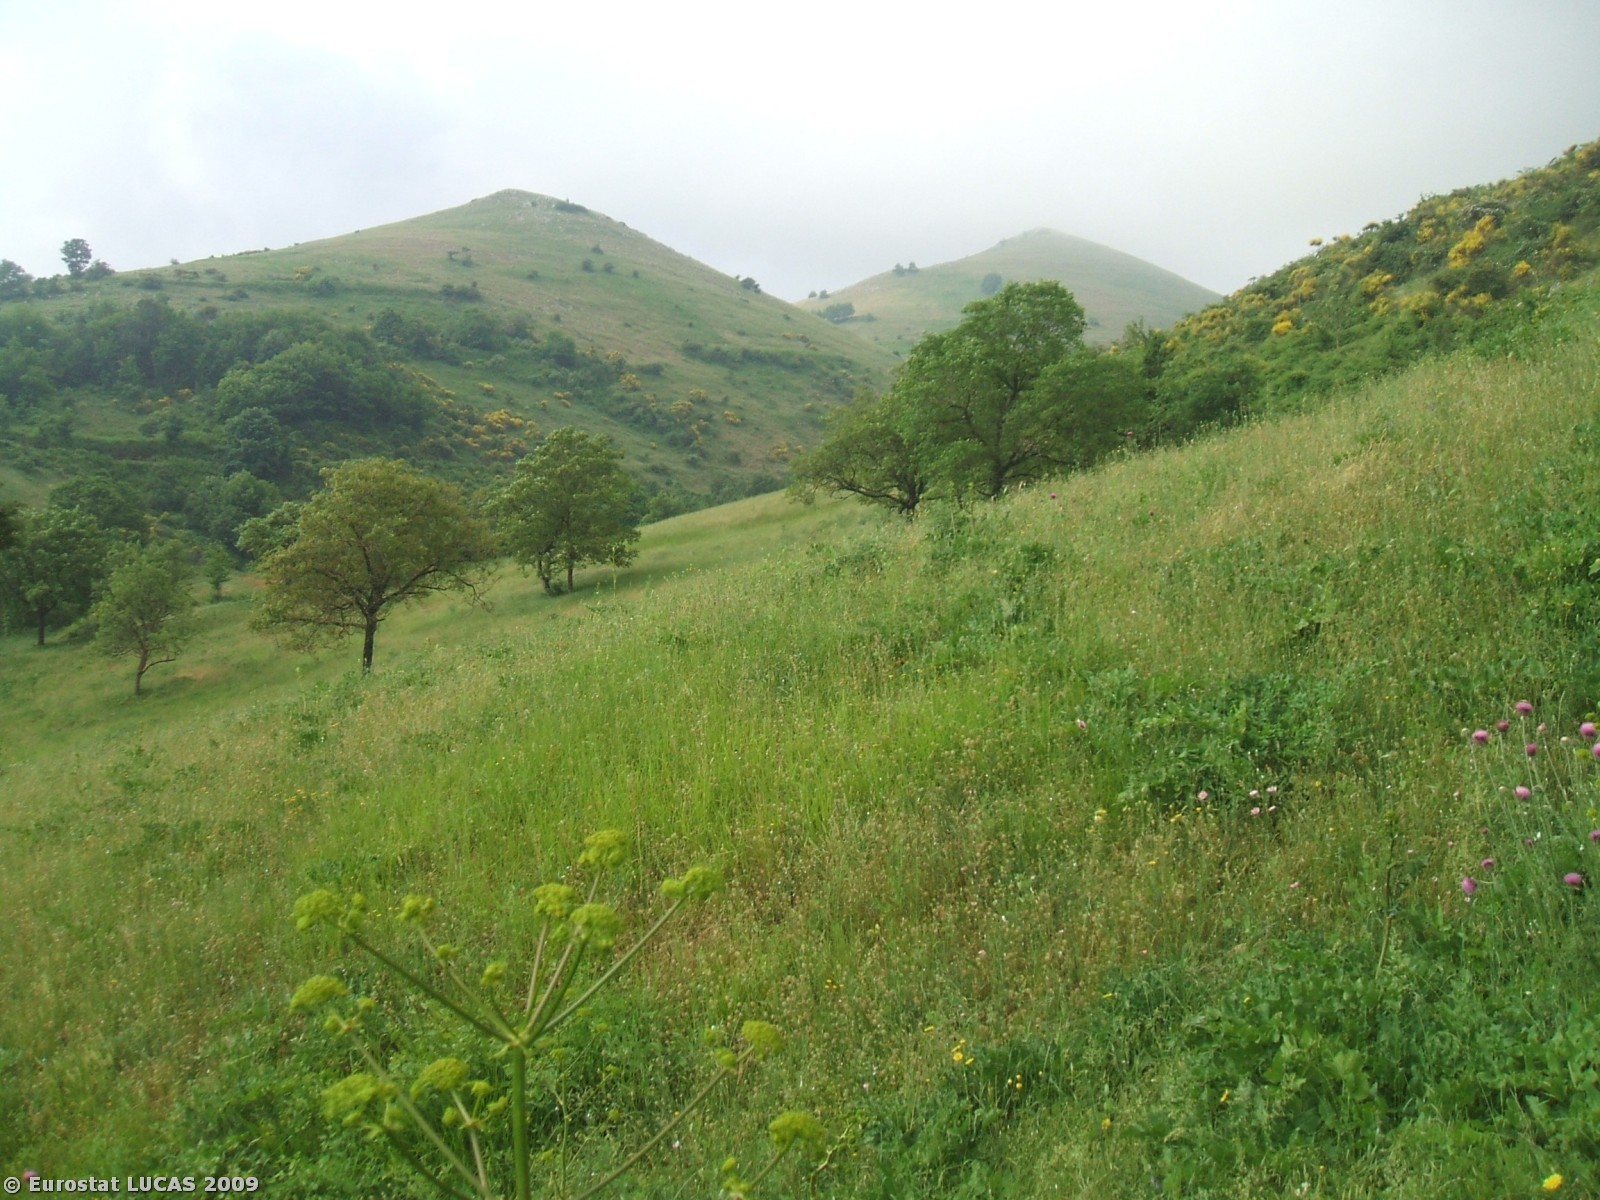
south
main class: Shrubland
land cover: Shrubland without tree cover
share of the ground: > 75 %
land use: Fallow land
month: May
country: IT
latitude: 40.4879
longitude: 15.6047
